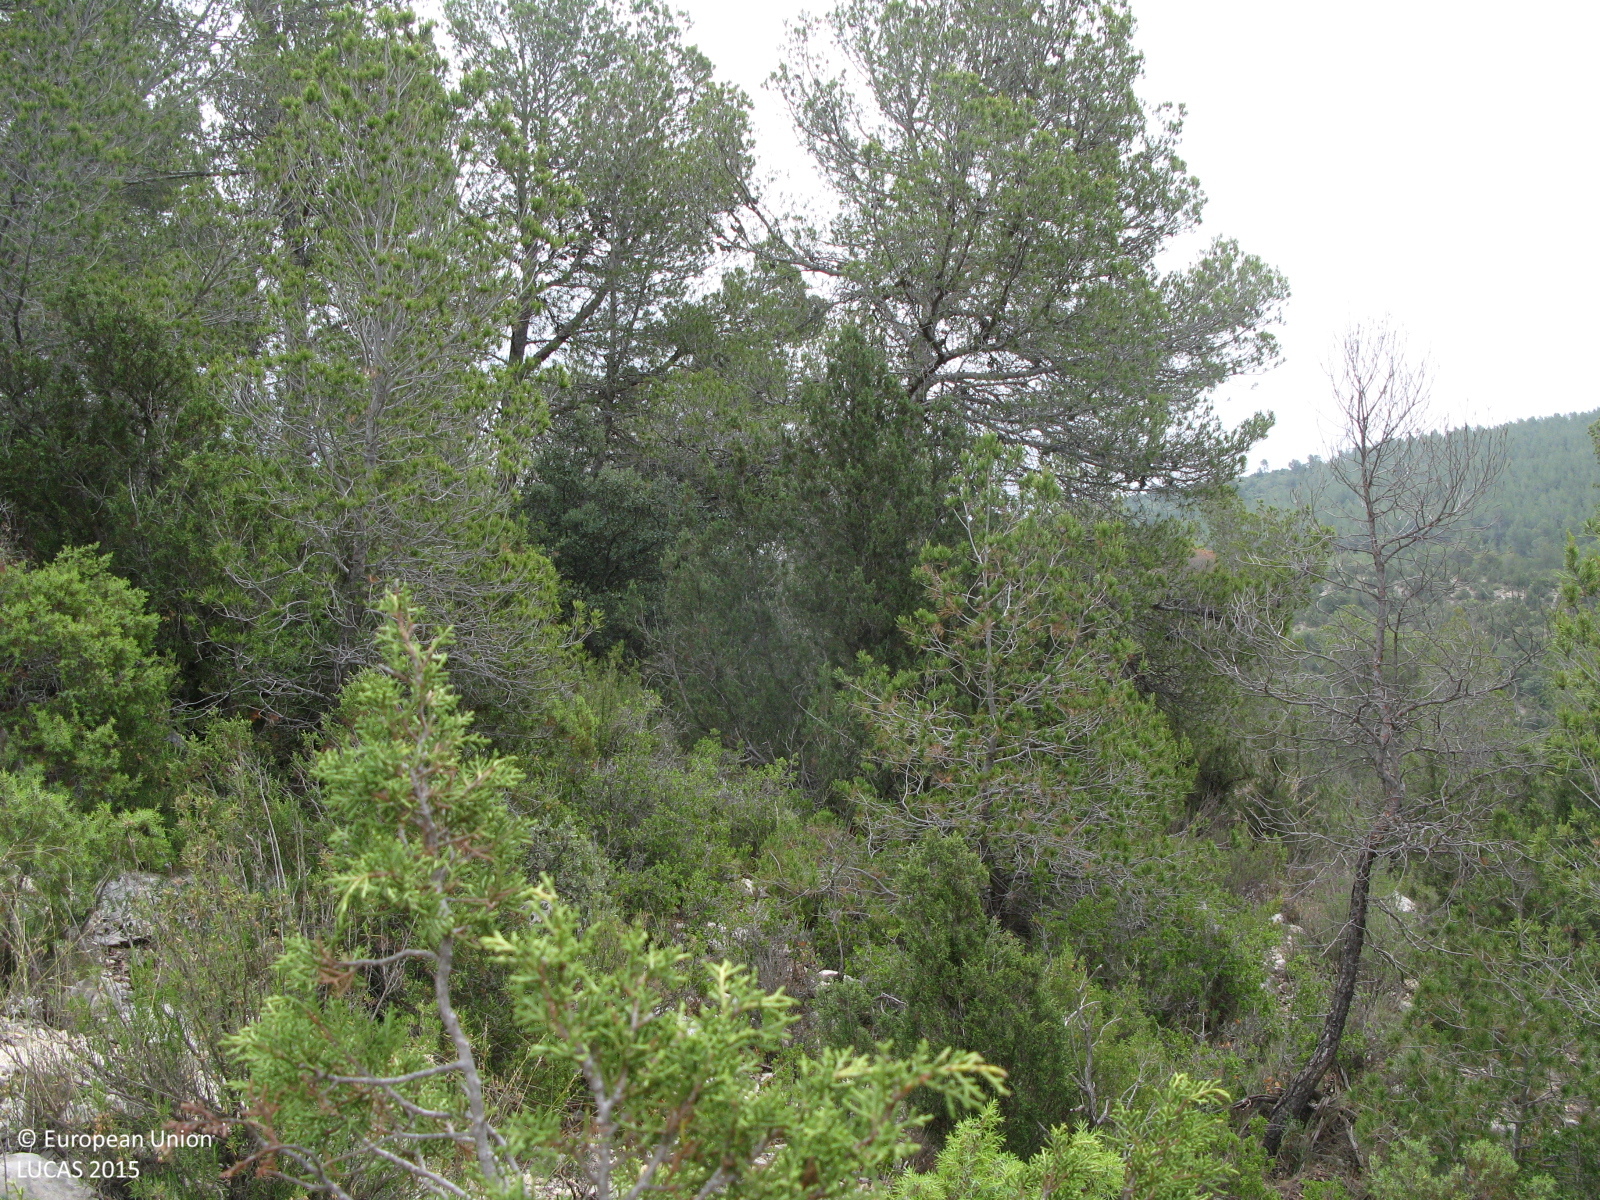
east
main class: Woodland
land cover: Pine dominated coniferous woodland
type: coniferous forest of the mediterranean region
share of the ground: 10 - 25 %
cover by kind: consolidated bare surface 40 %, shrubs 25 %, coniferous forest trees 15 %, herbaceous plants 15 %, broadleaved forest trees 5 %
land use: Forestry
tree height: > 5 m
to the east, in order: Pine dominated coniferous woodland
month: June
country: ES
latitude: 39.9541
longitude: -1.1857
